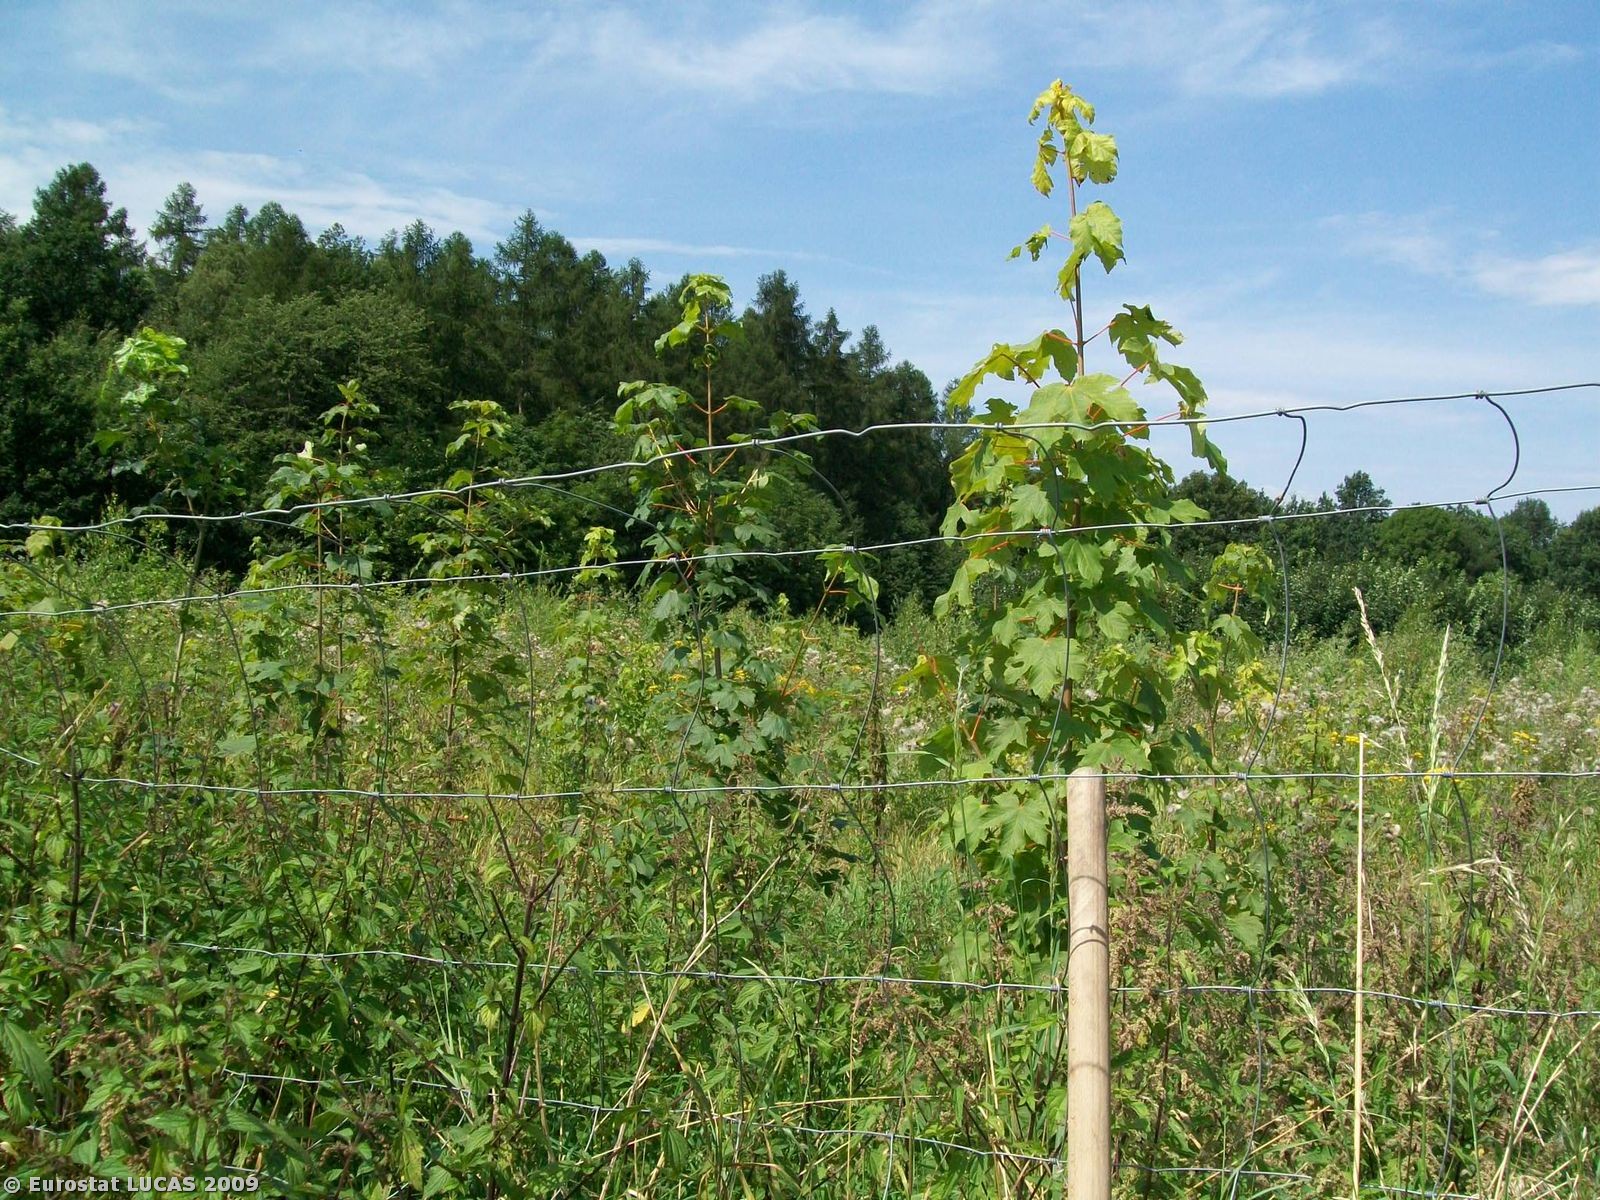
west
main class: Cropland
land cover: Triticale
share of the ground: > 75 %
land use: Agriculture (excluding fallow land and kitchen gardens)
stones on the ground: < 10 %
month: July
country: PL
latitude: 51.0683
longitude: 16.0712
